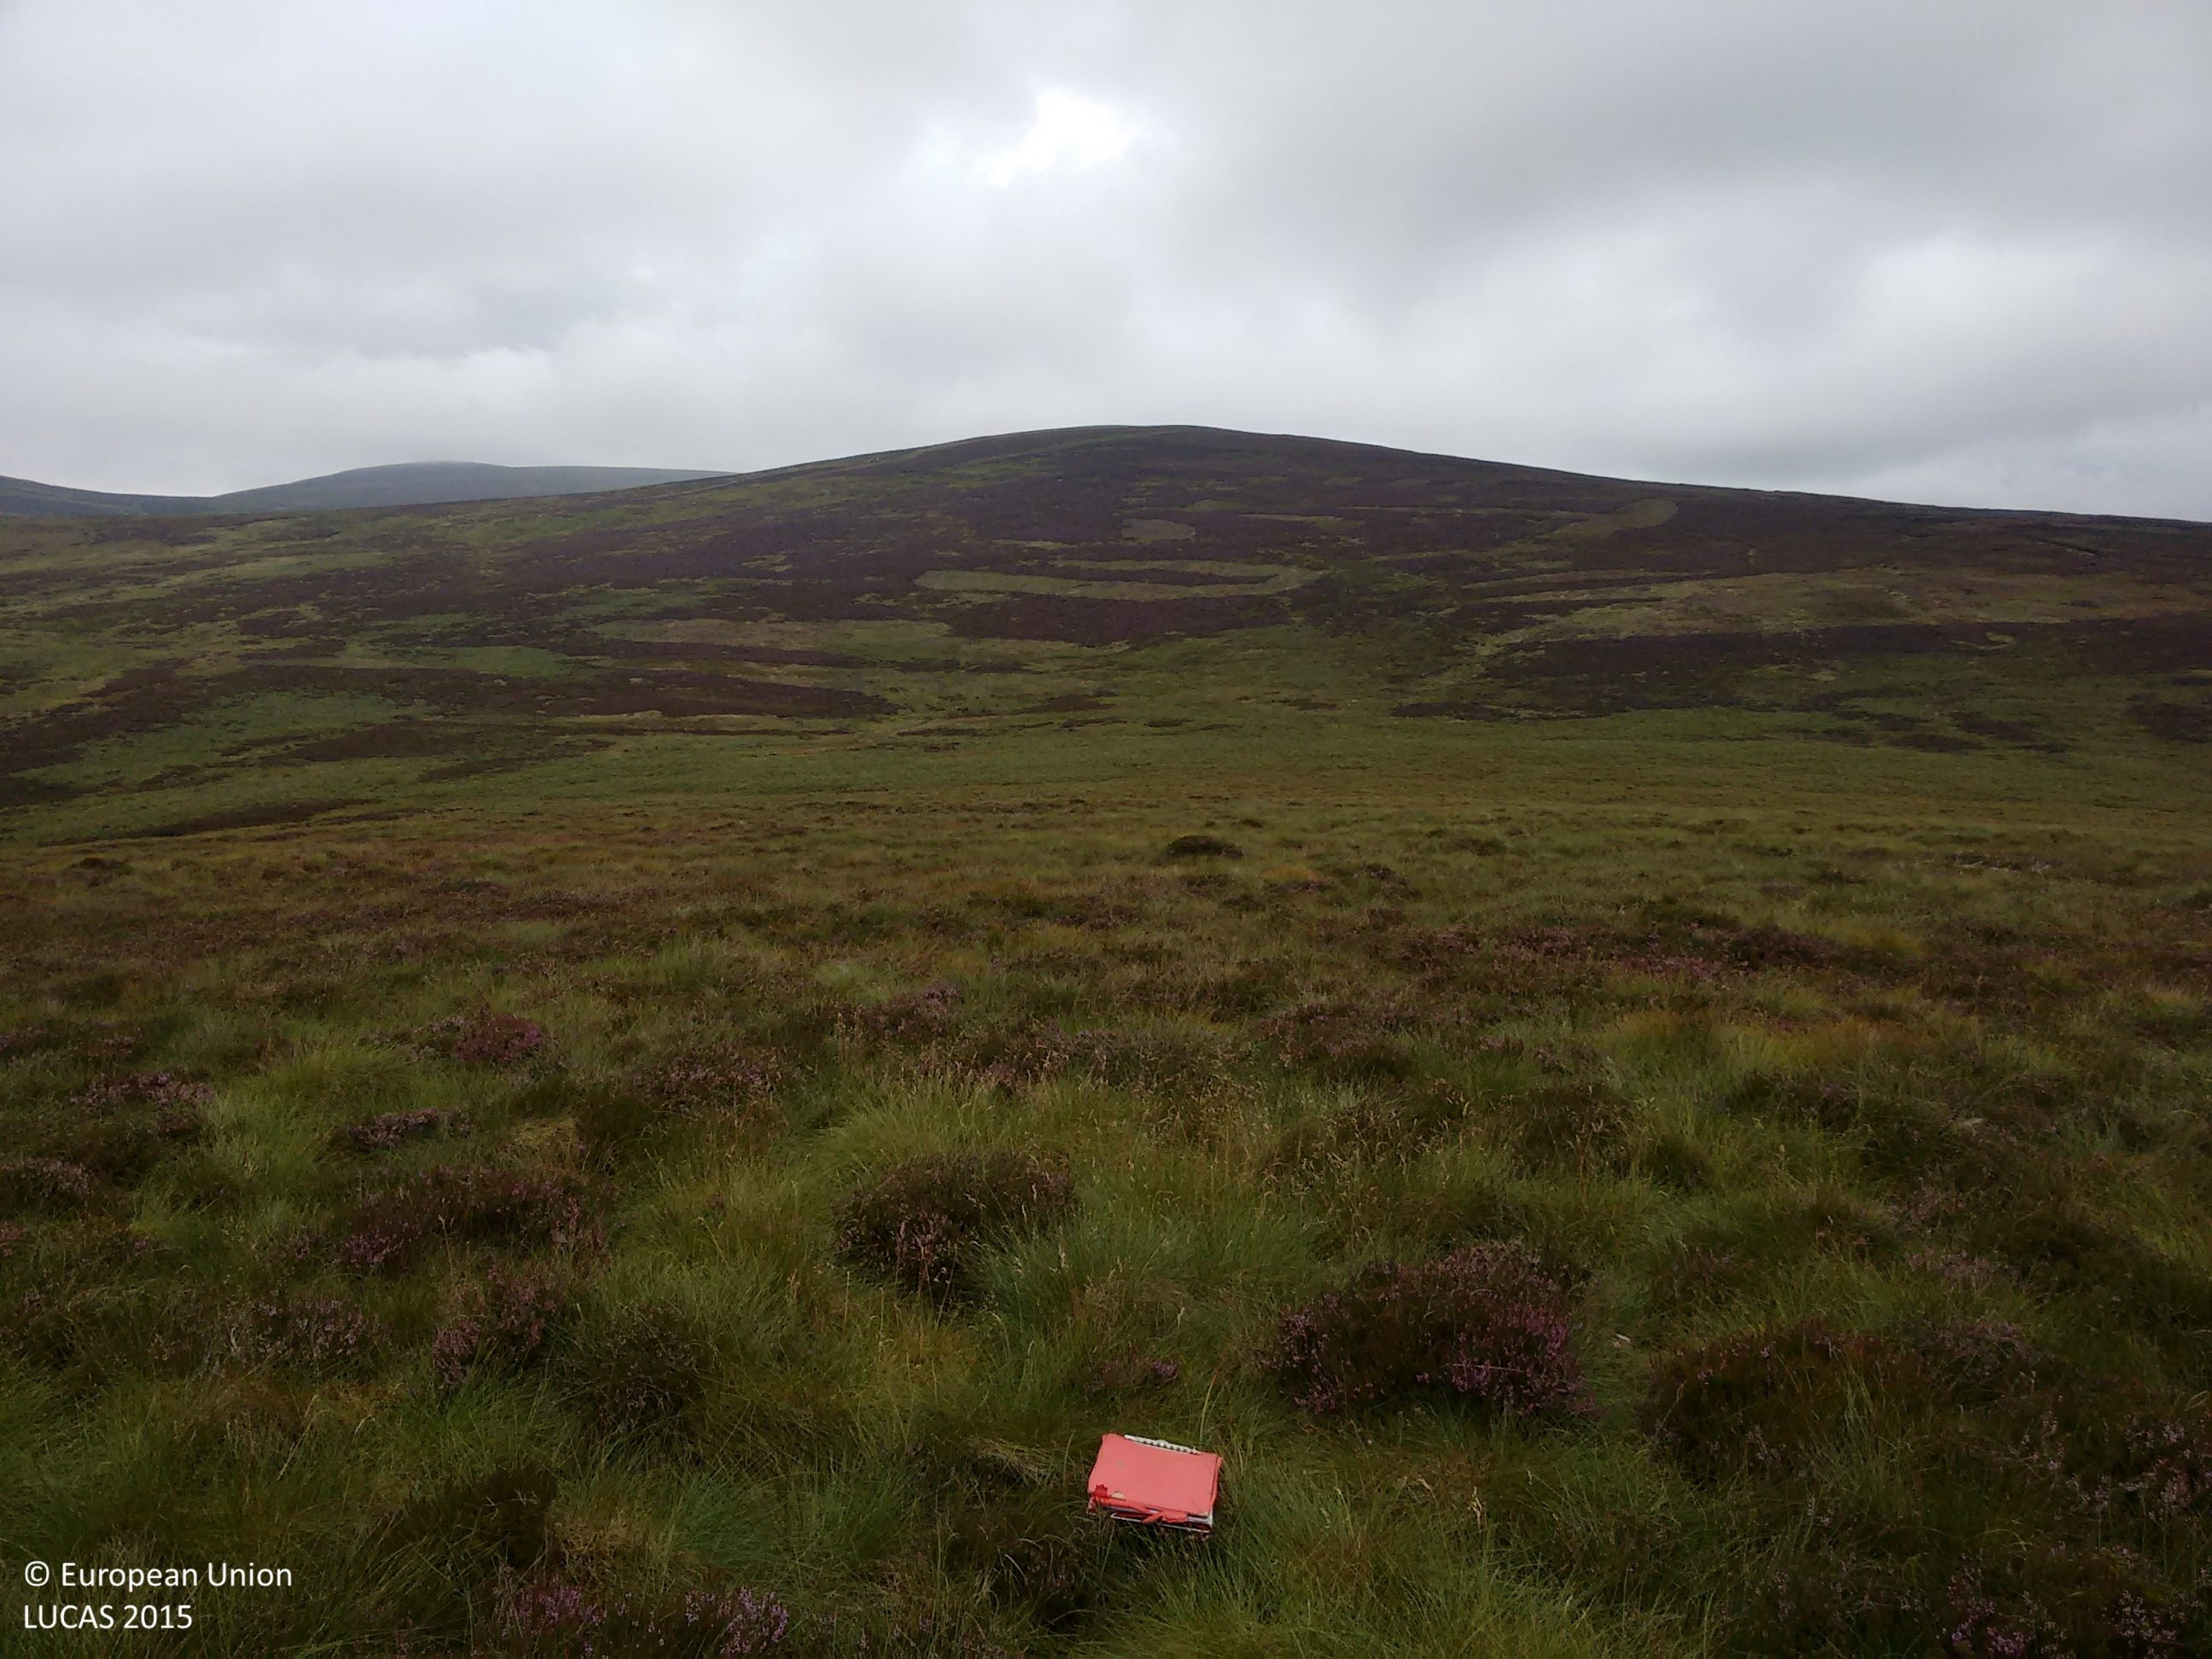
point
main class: Shrubland
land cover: Shrubland without tree cover
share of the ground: > 75 %
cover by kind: shrubs 70 %, herbaceous plants 30 %
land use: Agriculture (excluding fallow land and kitchen gardens)
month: August
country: GB
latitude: 56.9392
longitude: -2.6979
